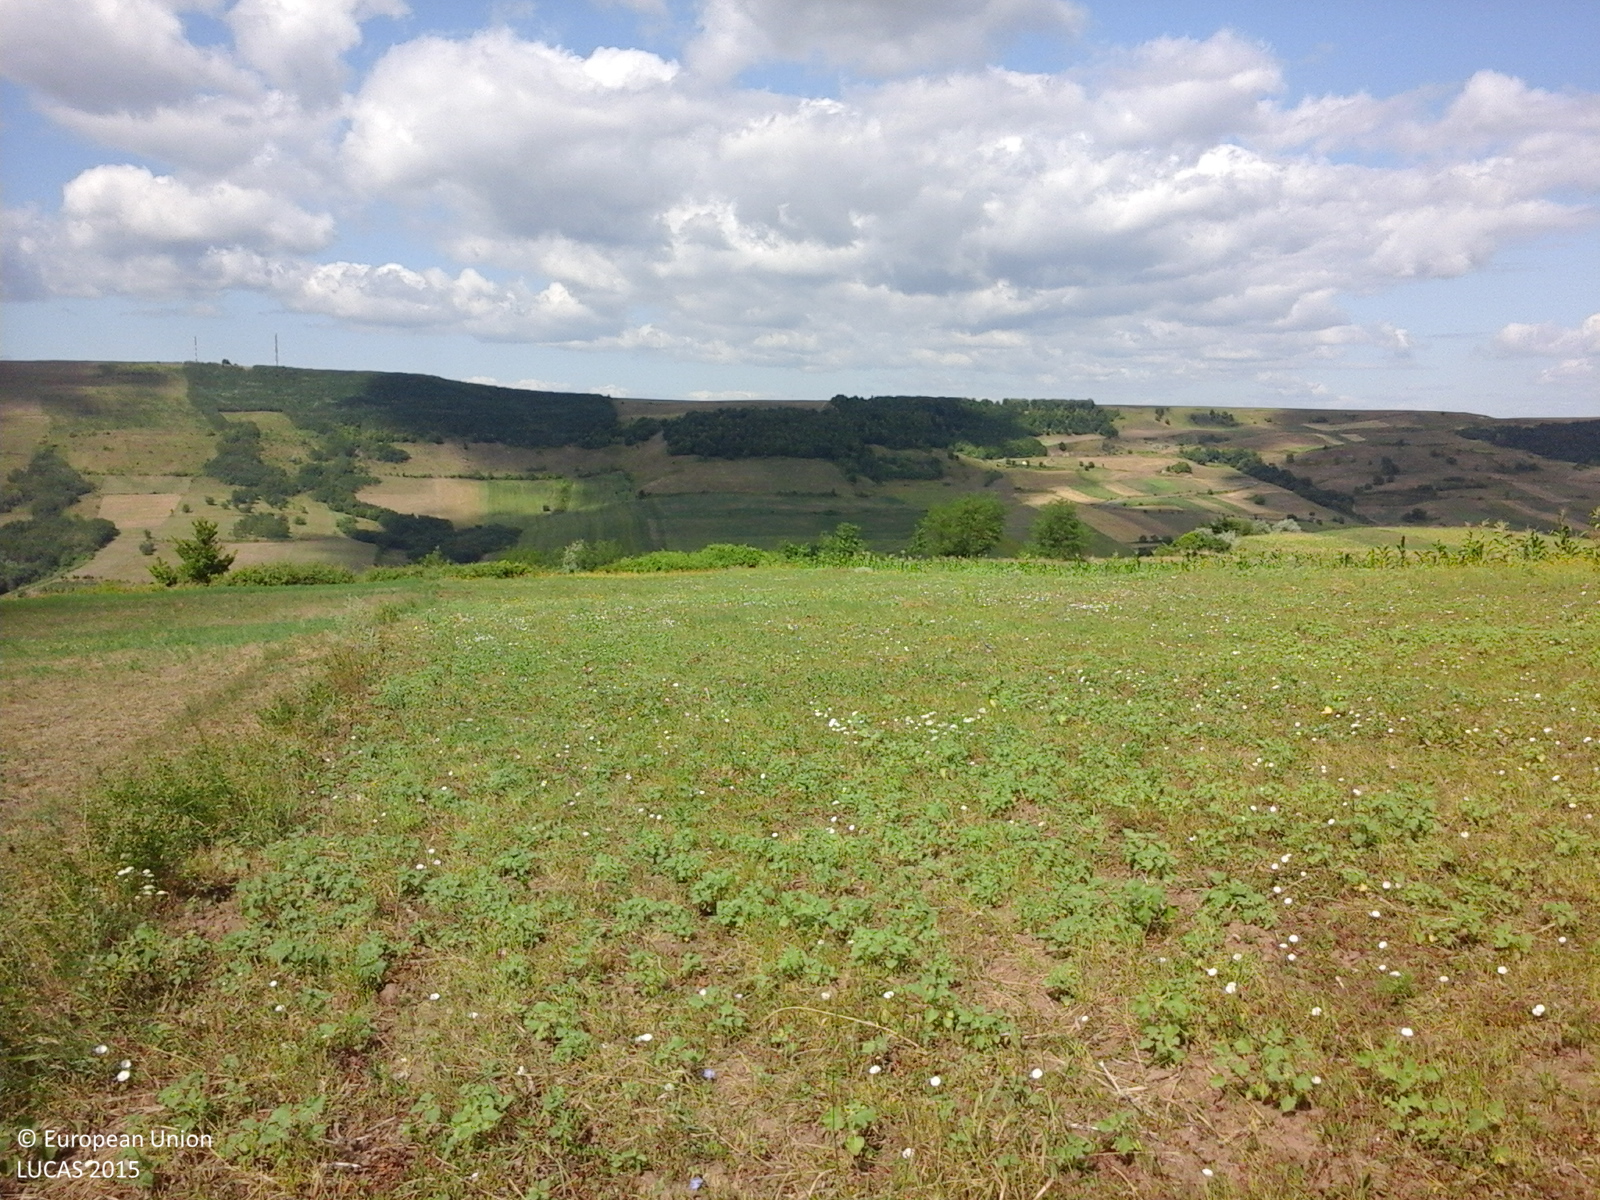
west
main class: Grassland
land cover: Grassland without tree/shrub cover
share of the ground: 10 - 25 %
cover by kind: herbaceous plants 100 %
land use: Agriculture (excluding fallow land and kitchen gardens)
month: July
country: RO
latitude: 46.4156
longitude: 27.3170
